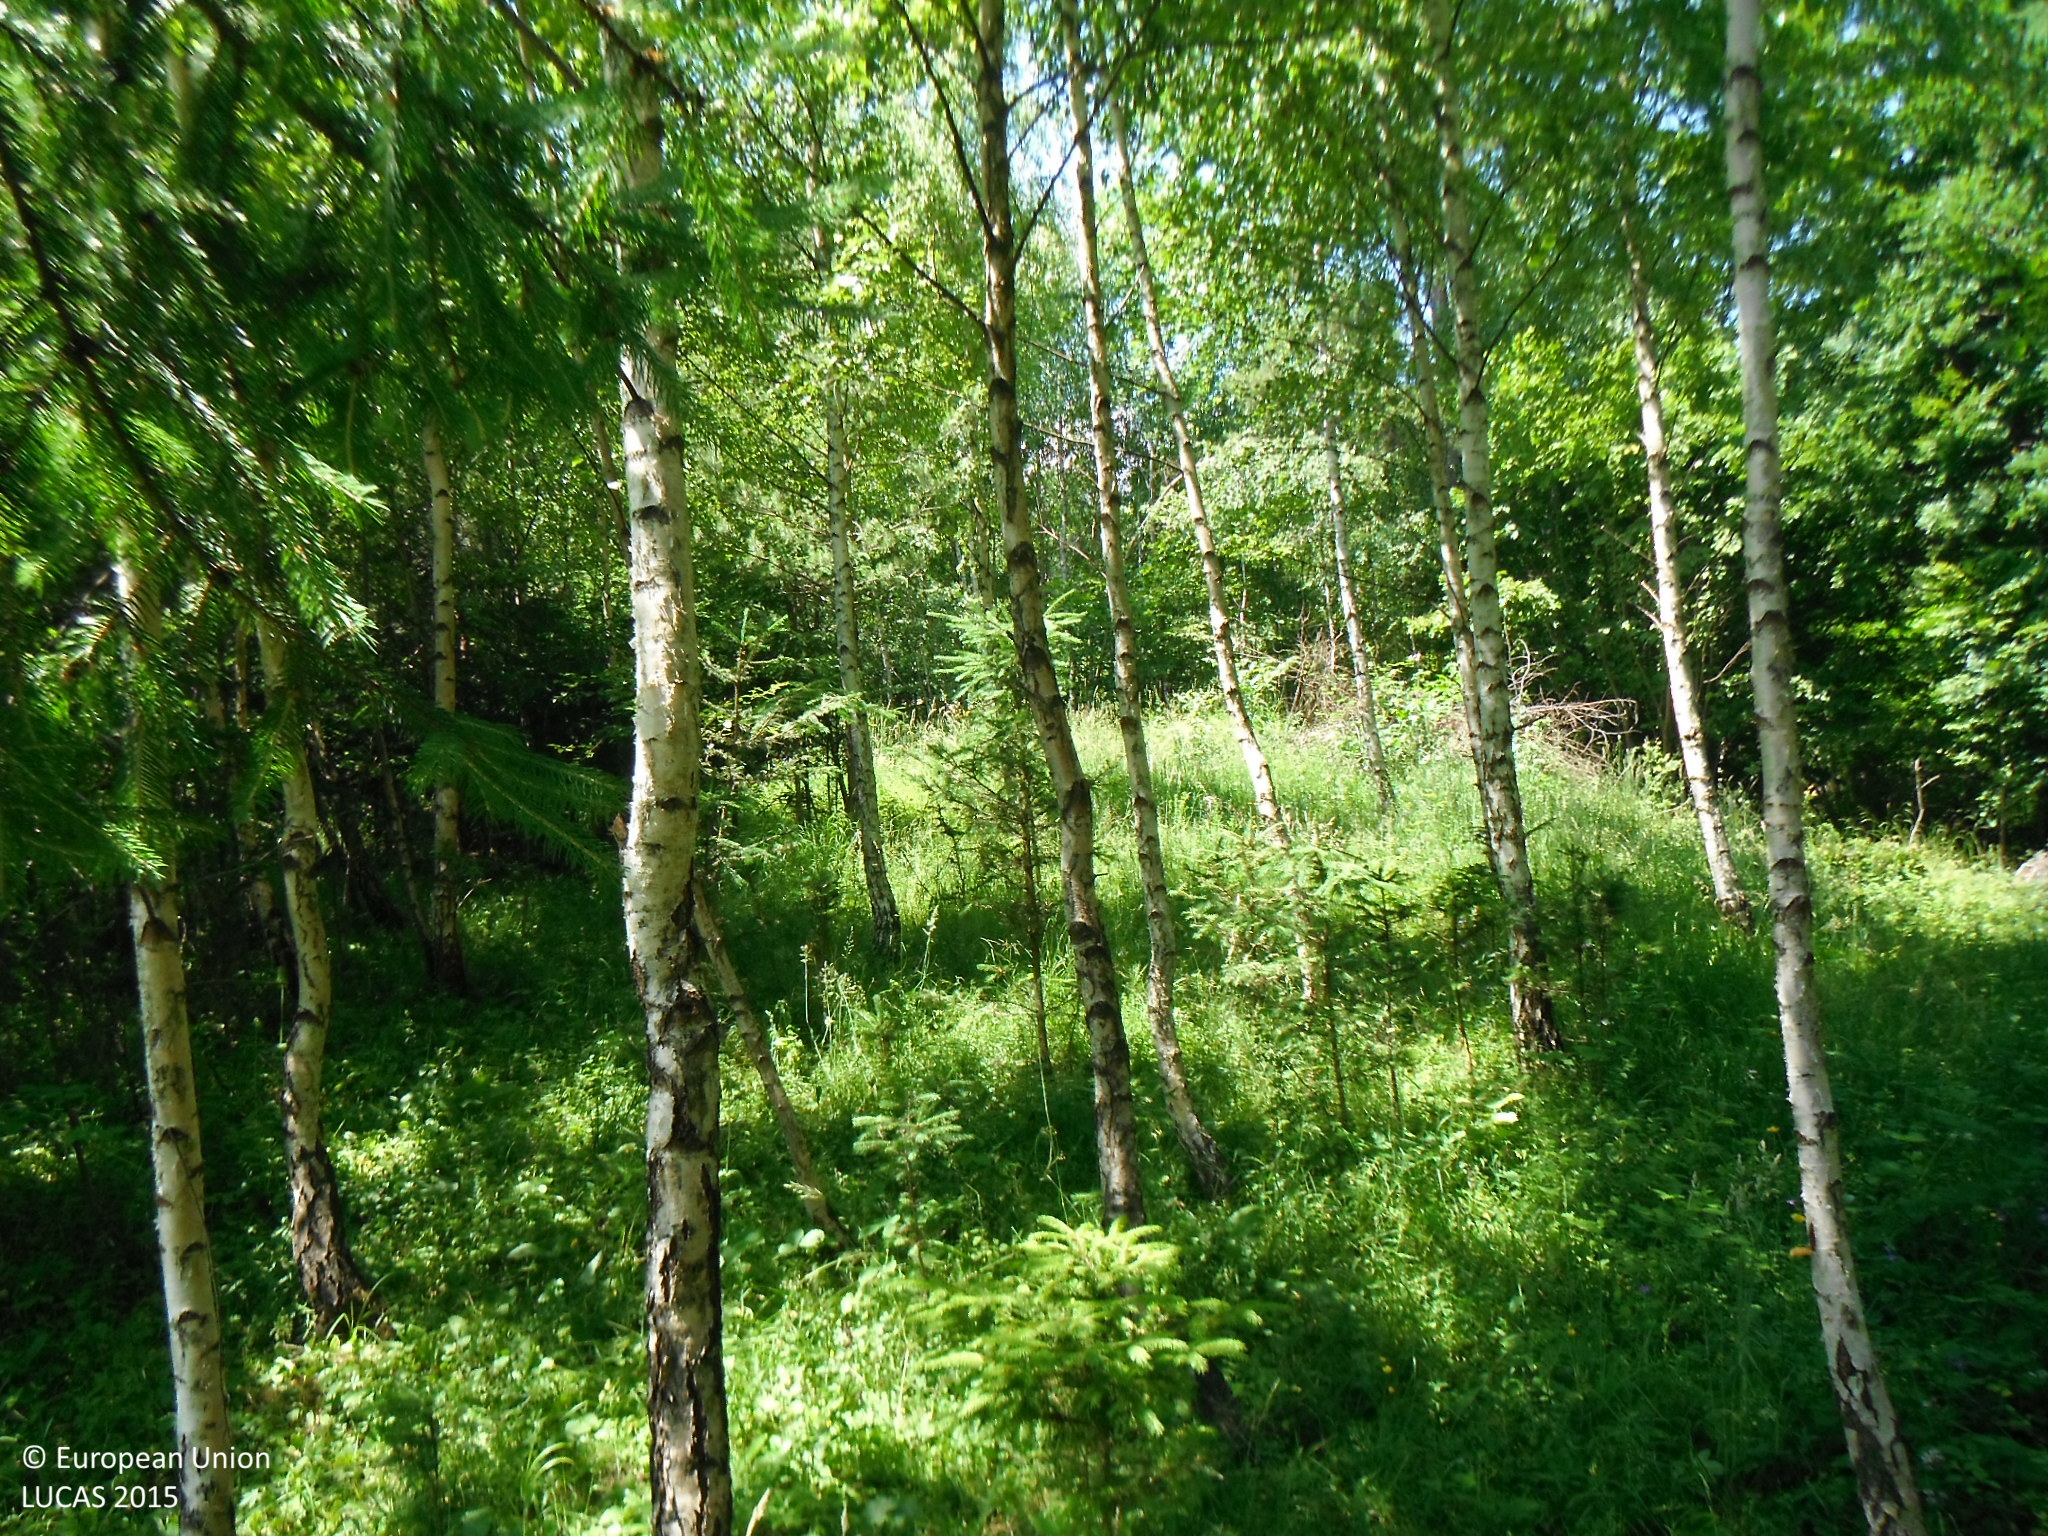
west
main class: Woodland
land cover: Spruce dominated mixed woodland
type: hemiboreal forest and nemoral coniferous forest and mixed broadleaved-coniferous forest
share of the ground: > 75 %
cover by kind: coniferous forest trees 50 %, broadleaved forest trees 25 %, herbaceous plants 15 %, shrubs 10 %
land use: Forestry
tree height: > 5 m
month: July
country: SK
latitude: 49.2698
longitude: 18.4978
